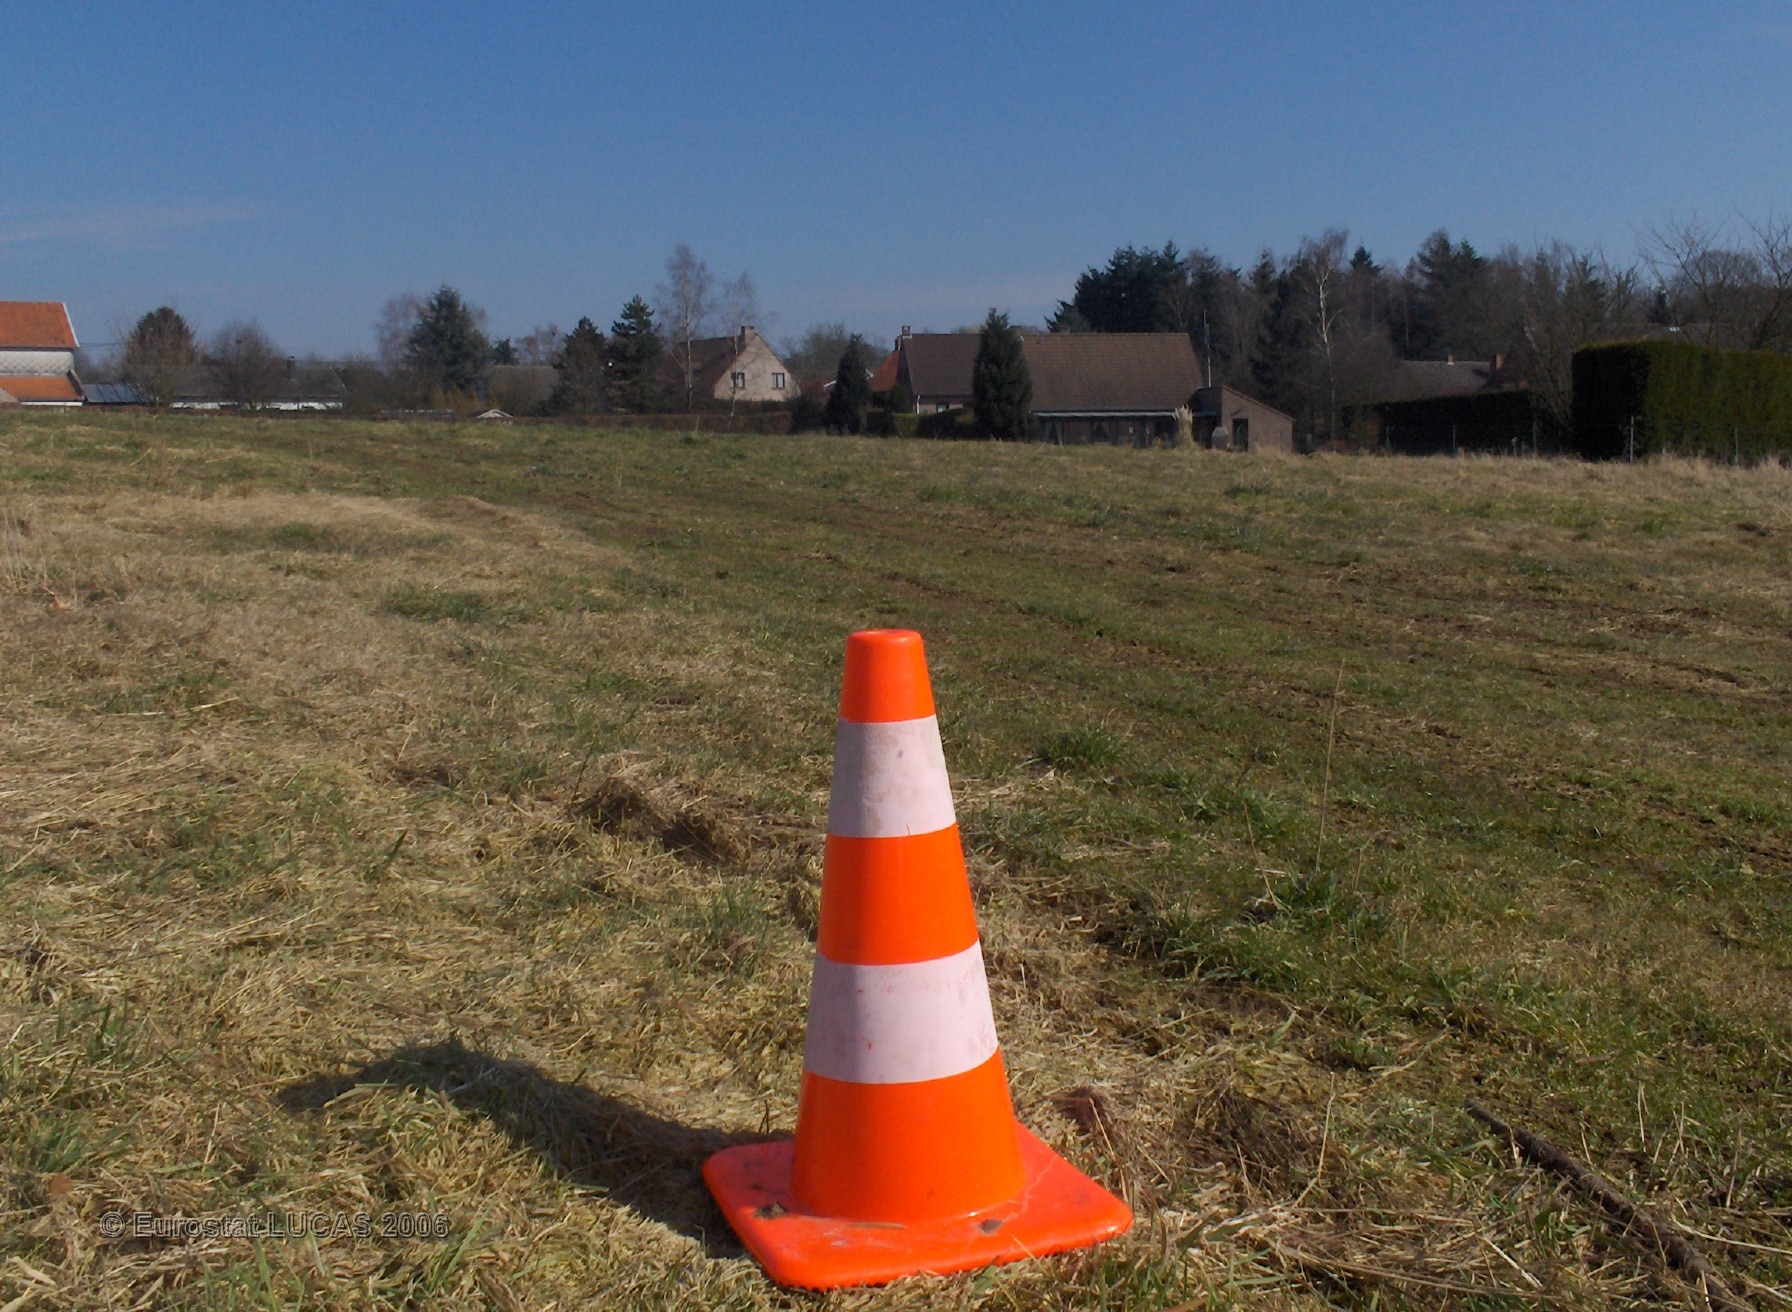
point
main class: Grassland
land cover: Grassland without tree/shrub cover
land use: Agriculture (excluding fallow land and kitchen gardens)
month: March
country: BE
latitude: 50.7011
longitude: 4.5164
